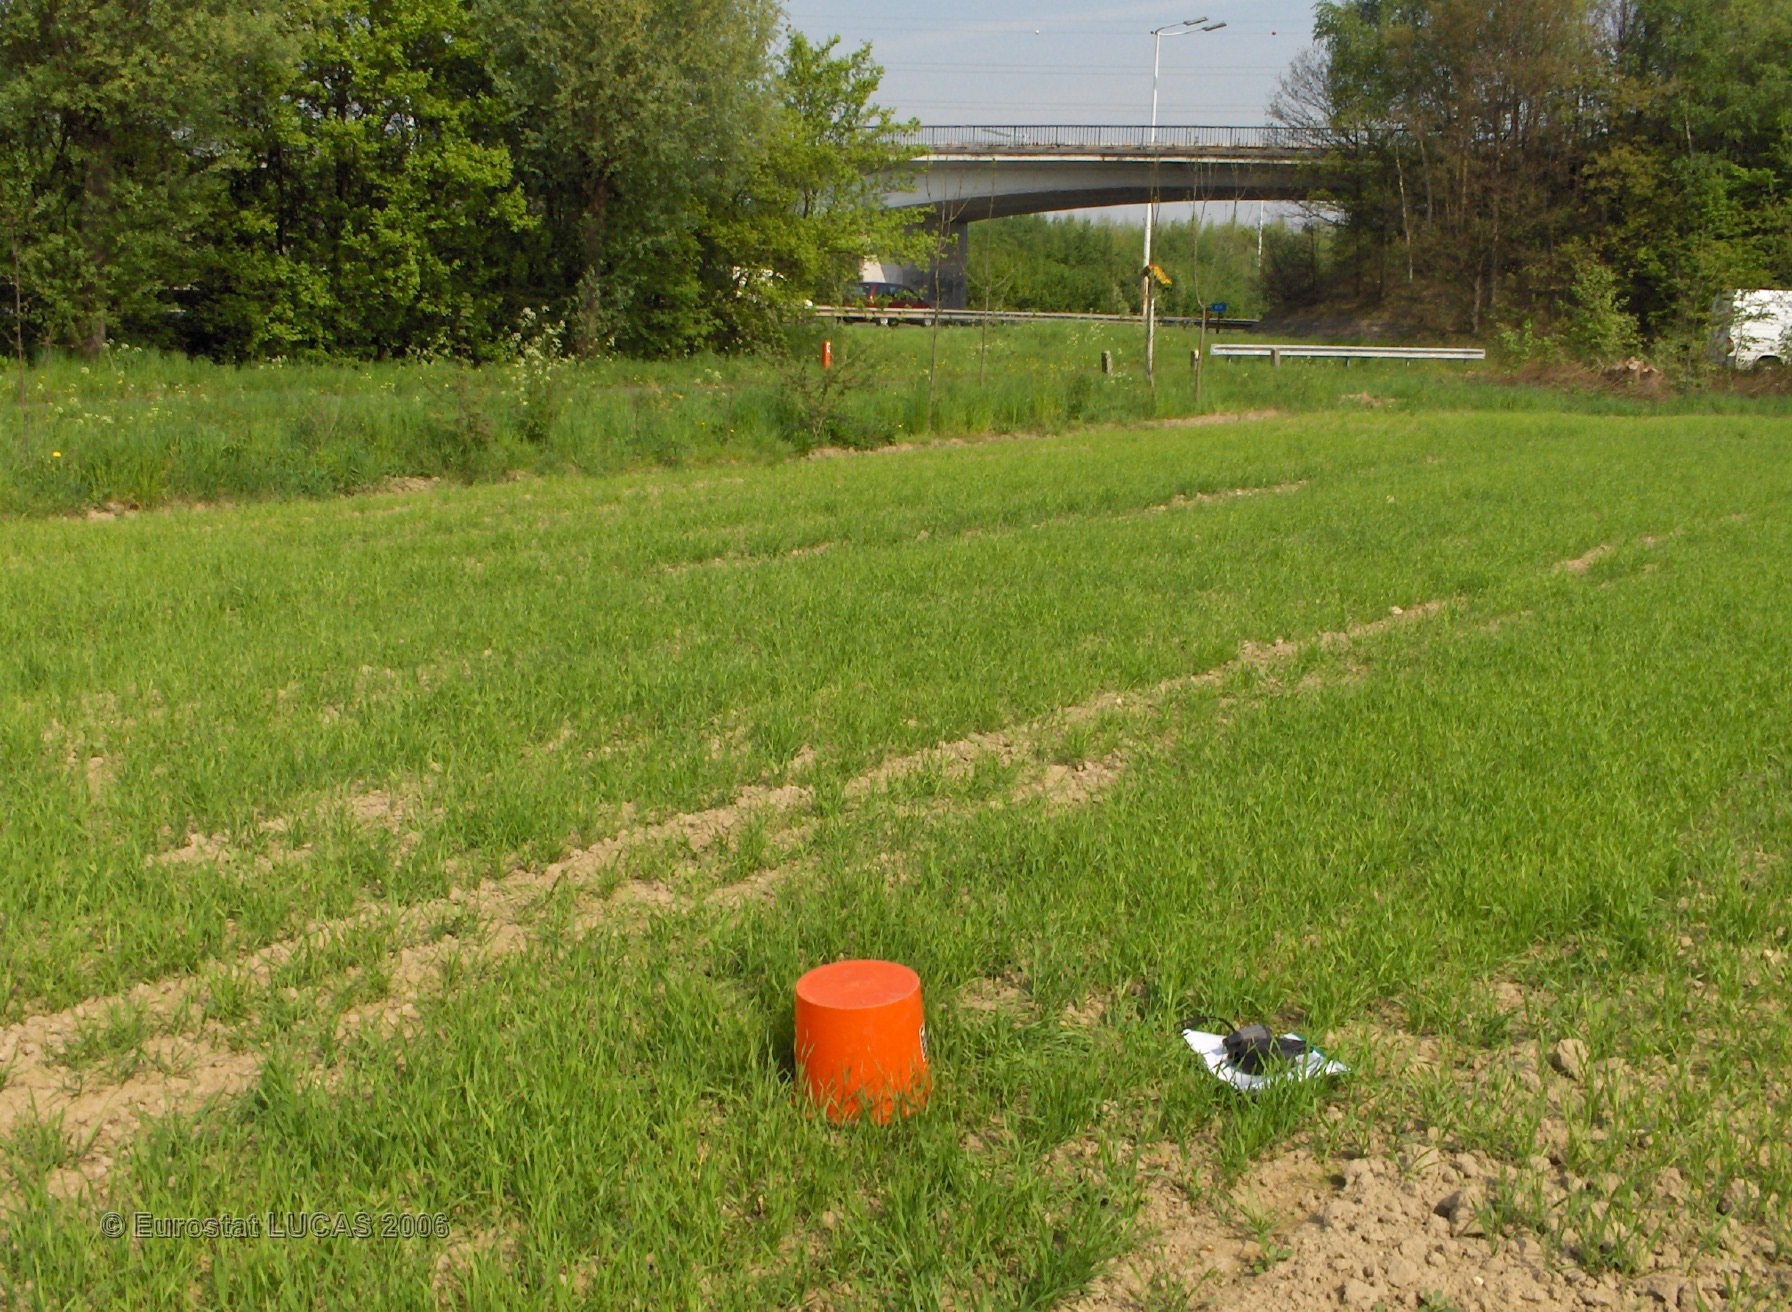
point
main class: Cropland
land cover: Common wheat
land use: Agriculture (excluding fallow land and kitchen gardens)
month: May
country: BE
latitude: 50.9520
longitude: 4.4868
